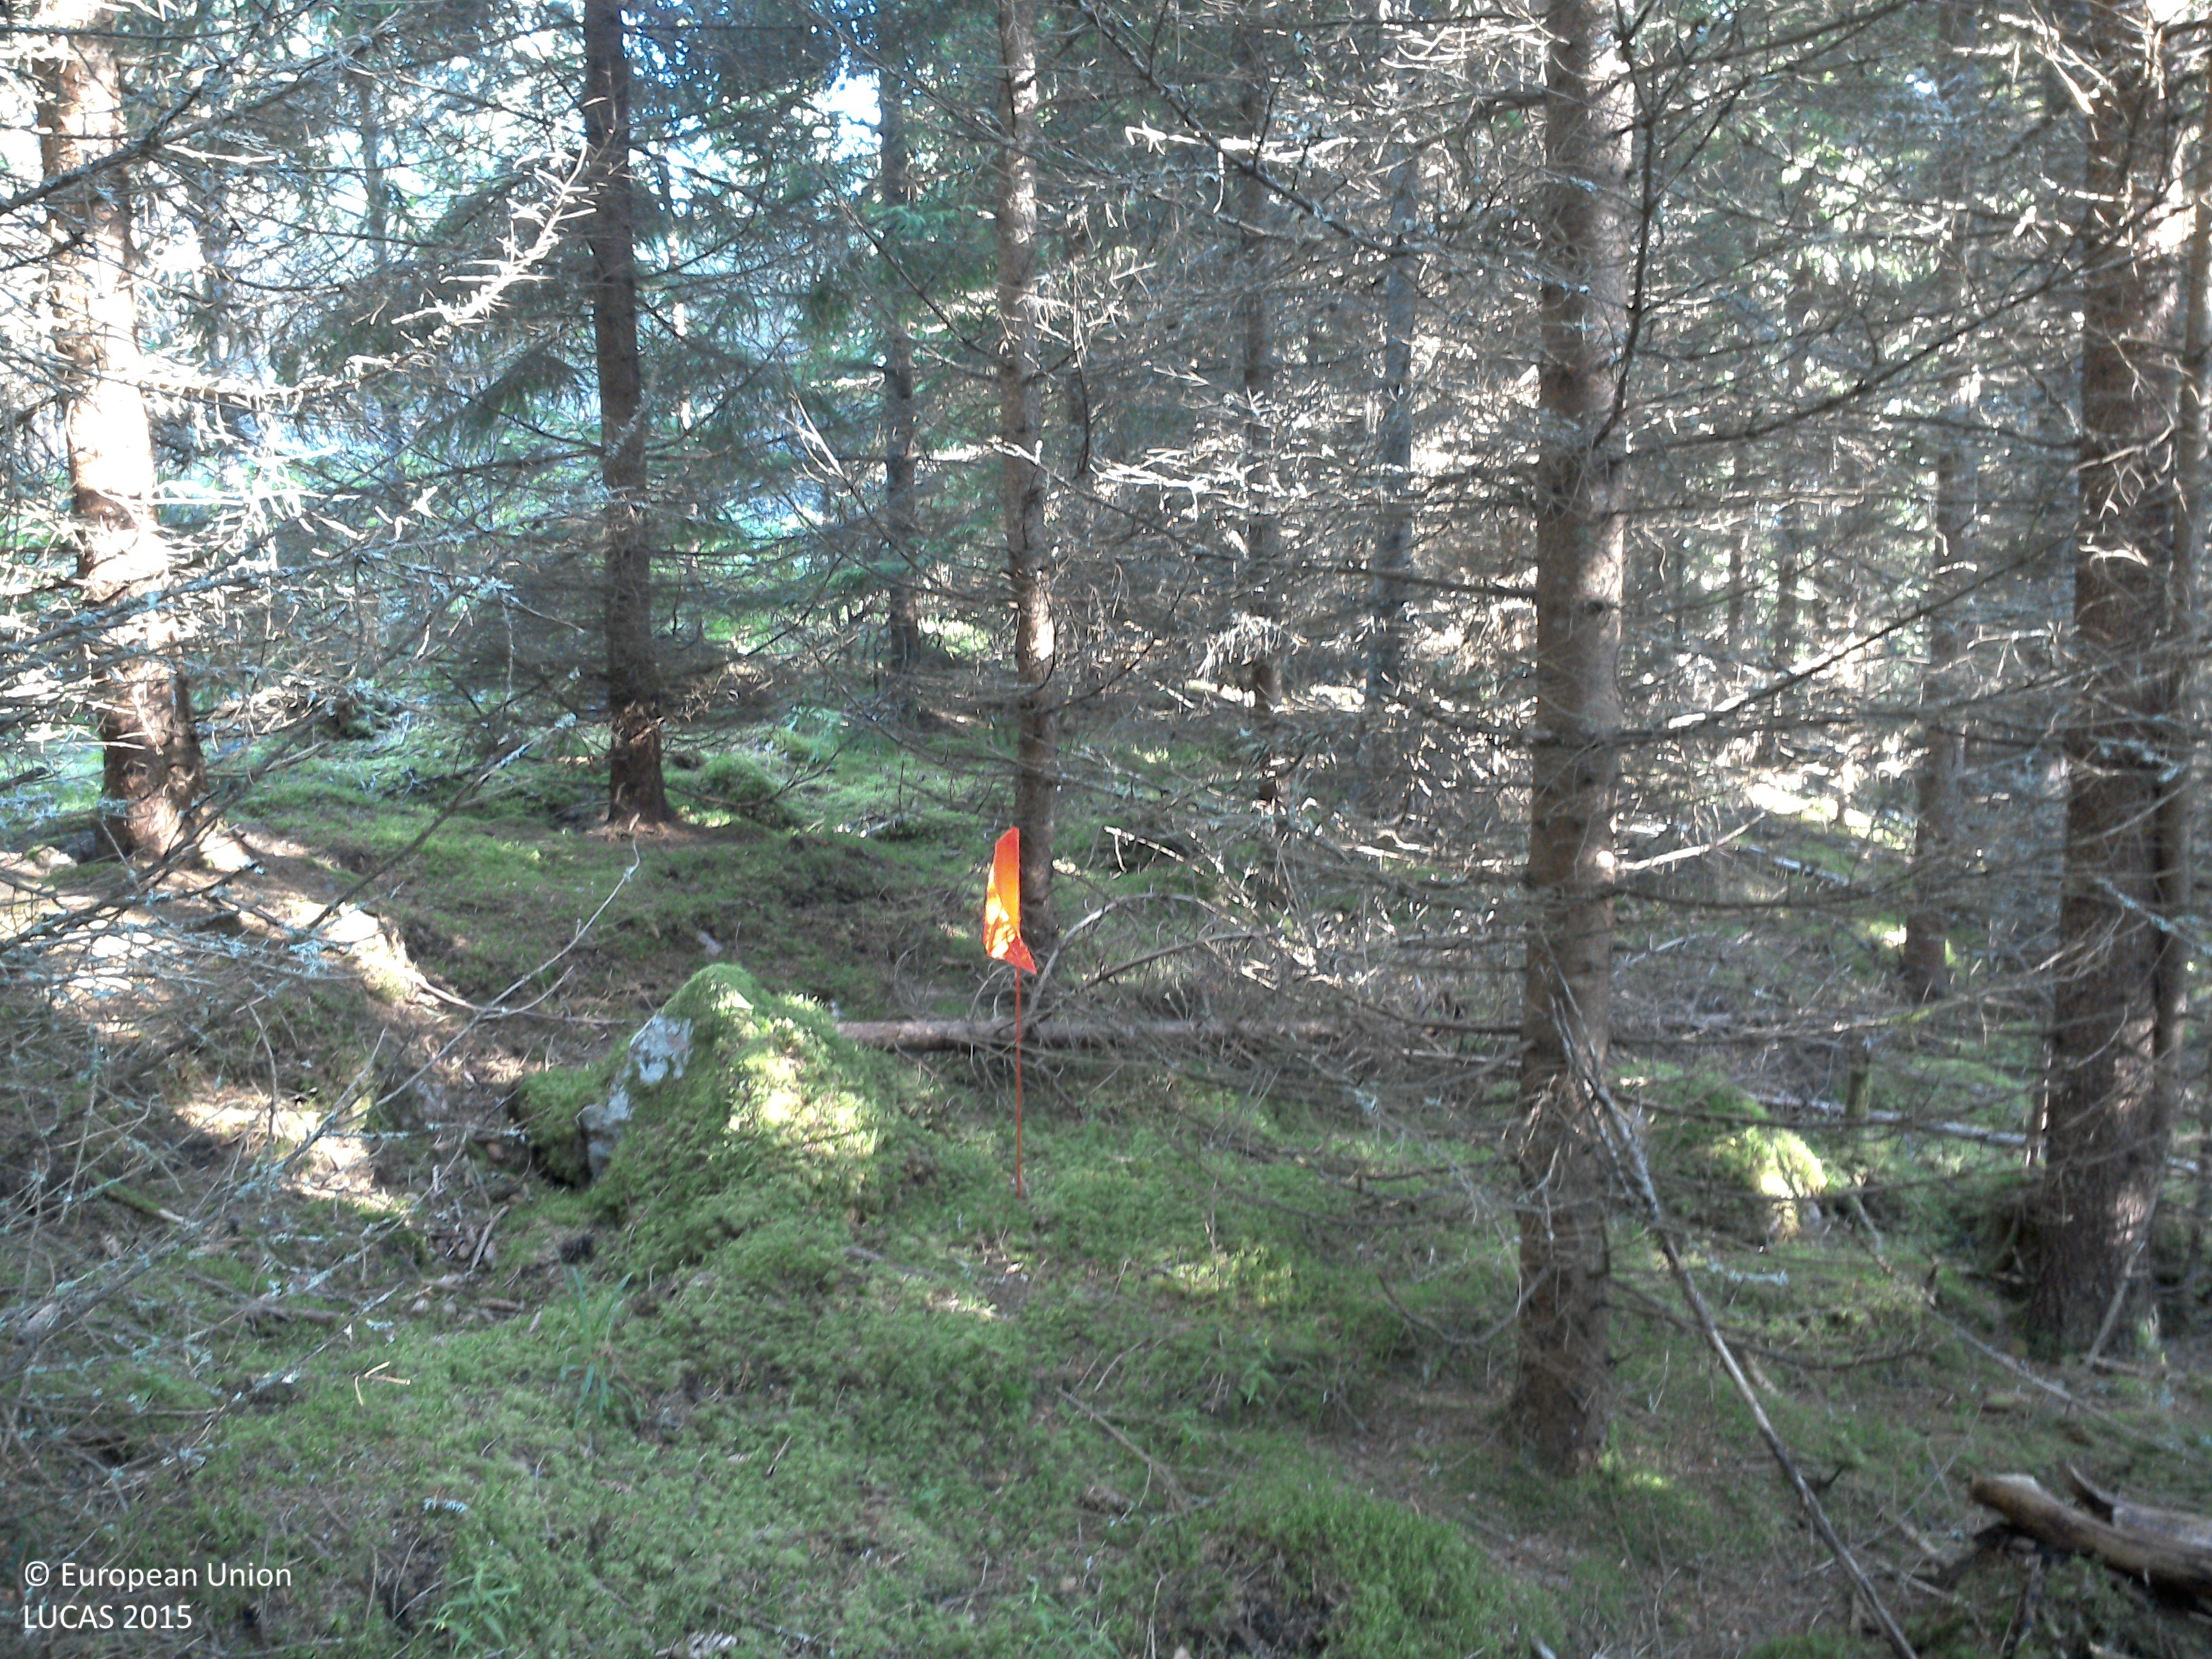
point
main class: Woodland
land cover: Spruce dominated coniferous woodland
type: boreal forest
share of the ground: > 75 %
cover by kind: coniferous forest trees 80 %, lichens and mosses 20 %
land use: Forestry
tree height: > 5 m
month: August
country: SE
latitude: 58.1289
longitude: 14.9359
